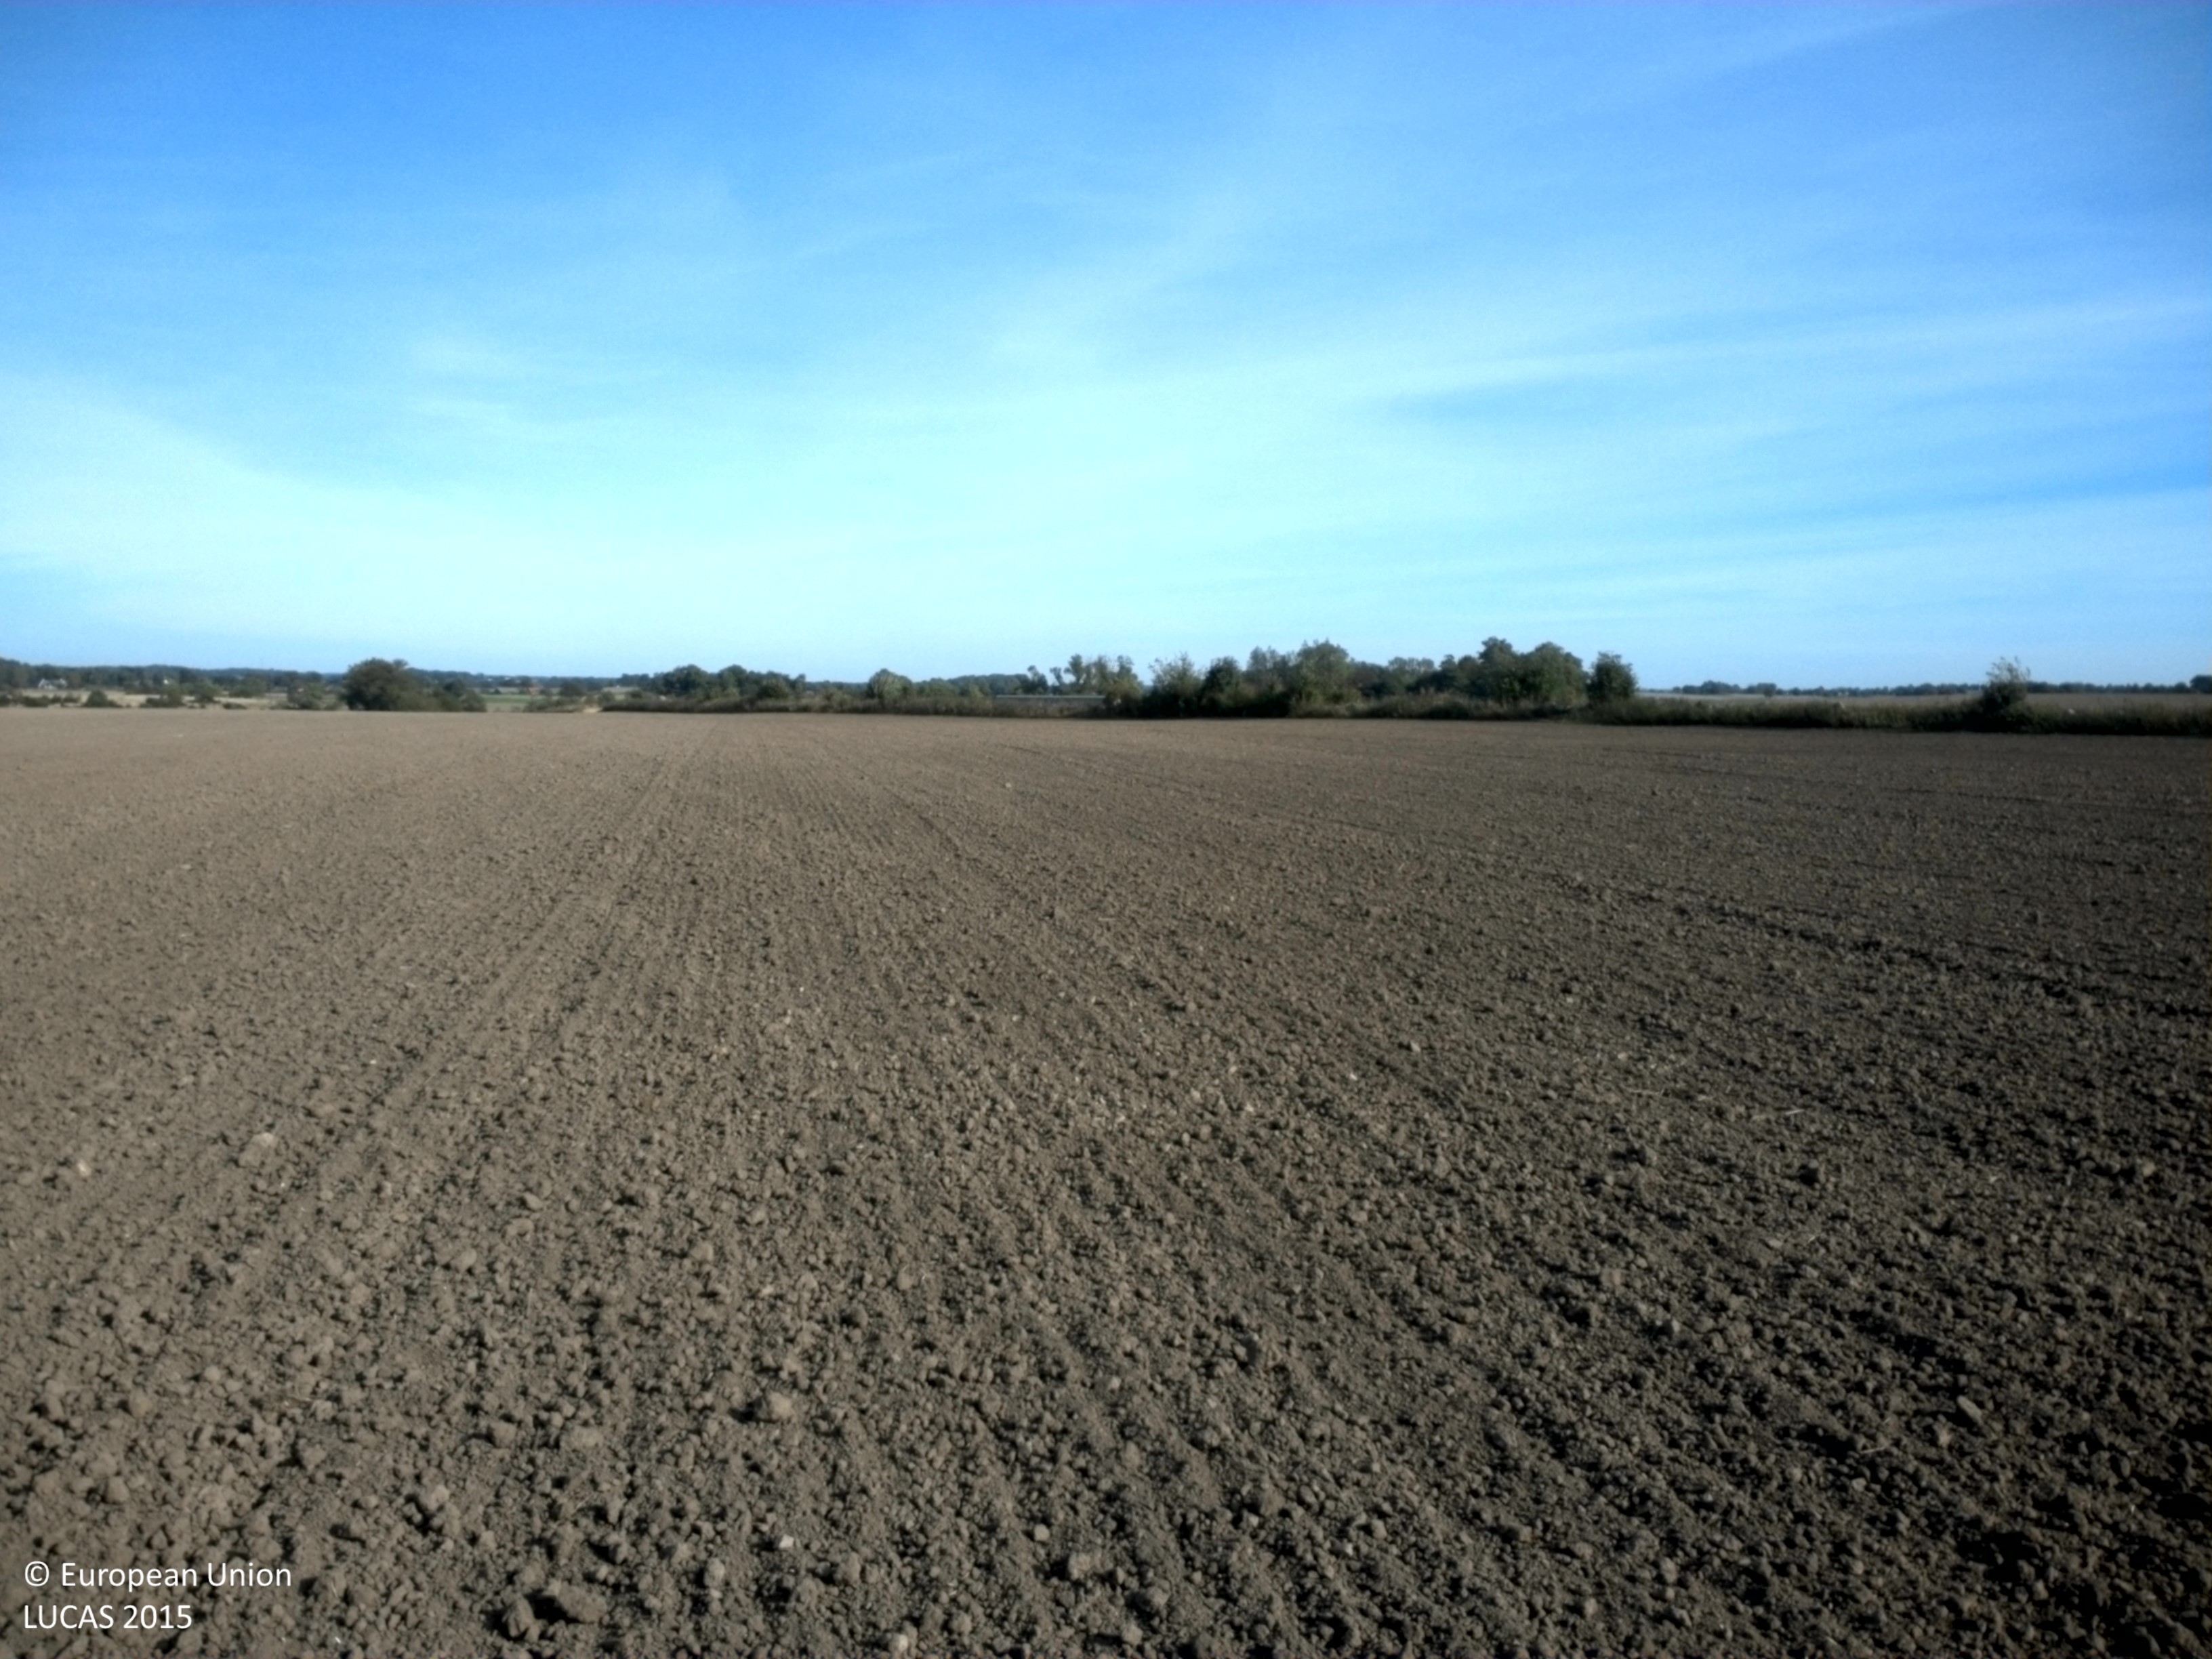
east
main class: Cropland
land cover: Common wheat
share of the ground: < 10 %
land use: Agriculture (excluding fallow land and kitchen gardens)
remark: Tilled/Sowed
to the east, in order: Common wheat; Abandoned hedges; Dry stone walls; Common wheat
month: October
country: SE
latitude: 55.7024
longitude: 13.7057
